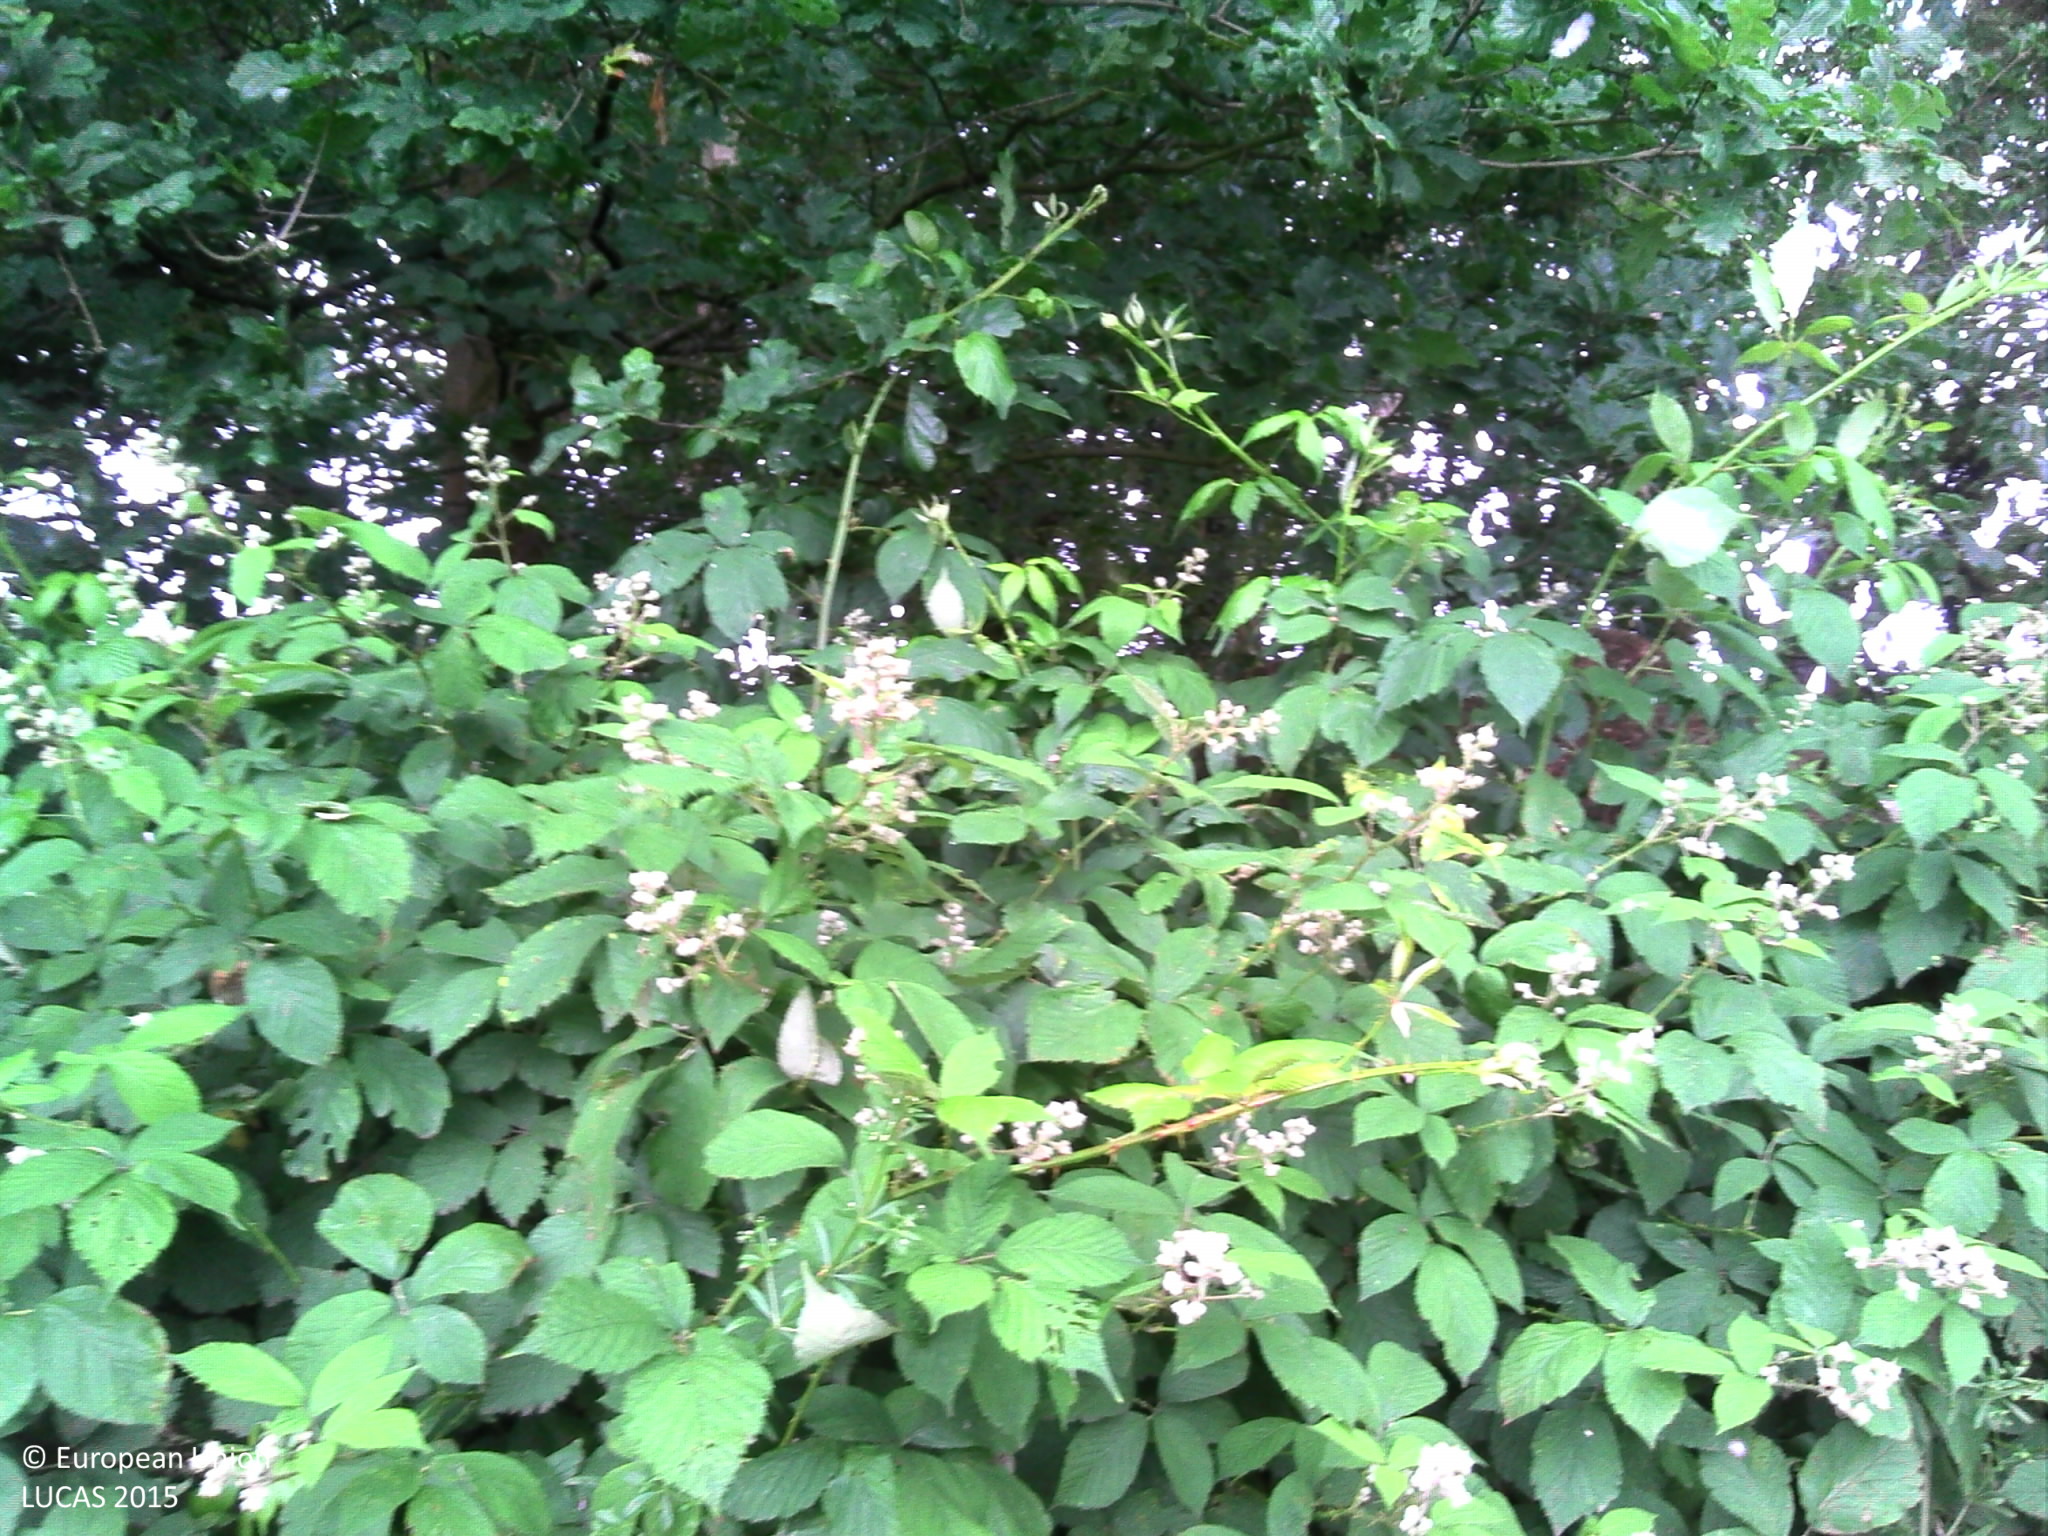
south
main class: Woodland
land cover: Broadleaved woodland
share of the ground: > 75 %
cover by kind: broadleaved forest trees 100 %
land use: Residential
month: June
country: BE
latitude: 51.1787
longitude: 3.9717
